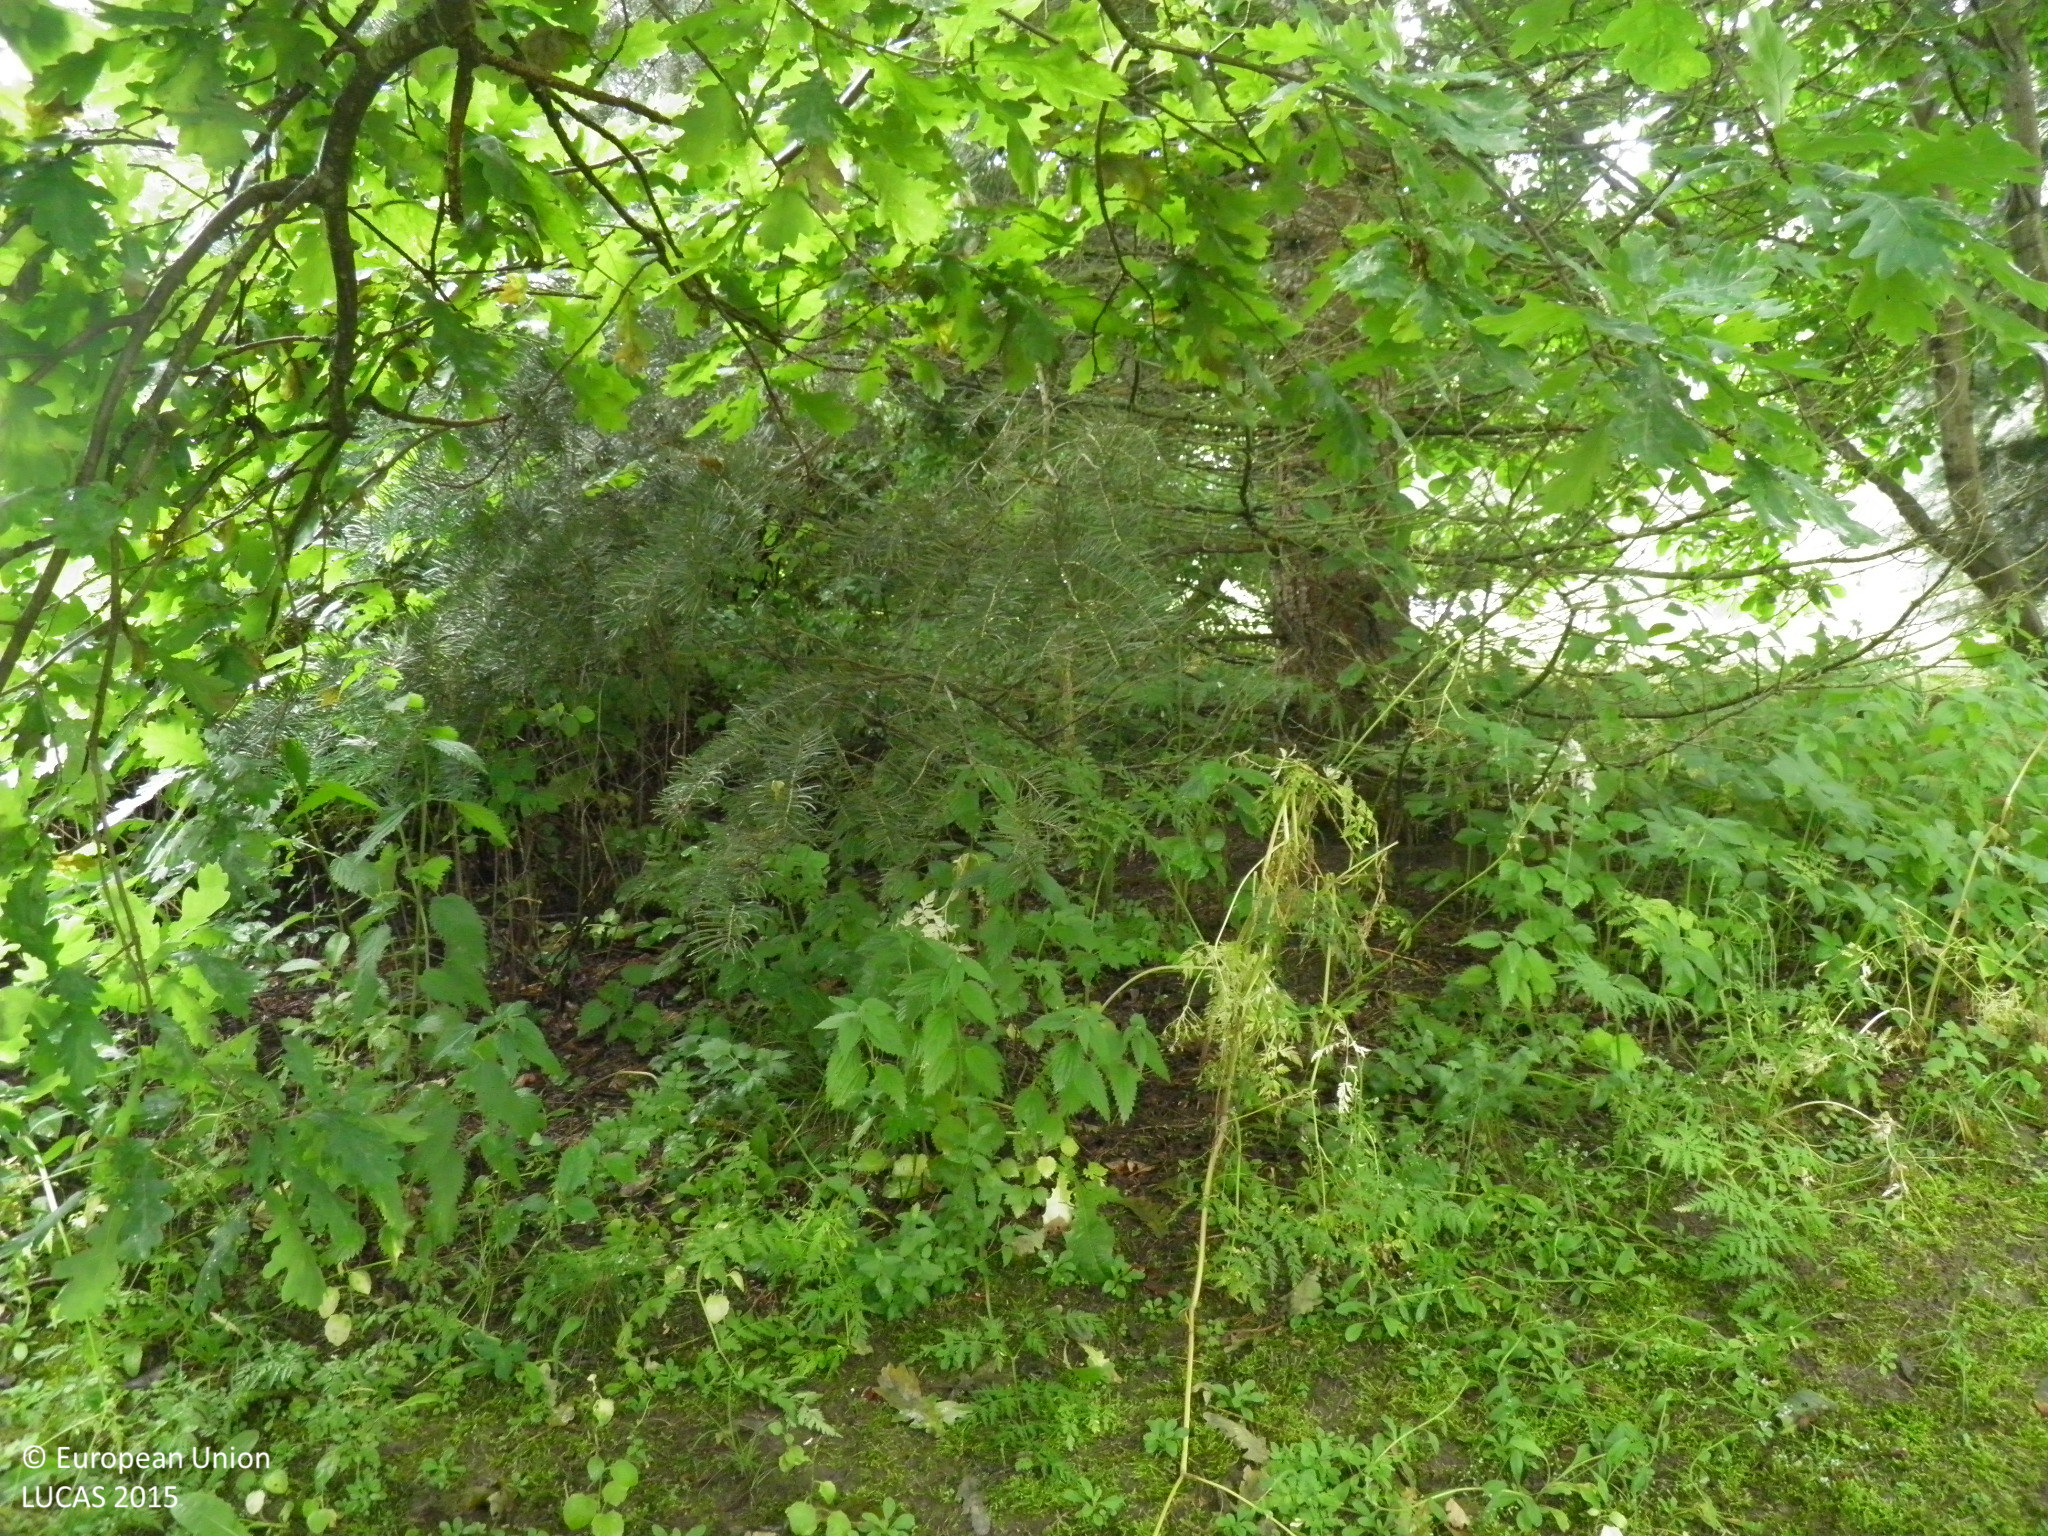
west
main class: Woodland
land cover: Spruce dominated mixed woodland
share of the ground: > 75 %
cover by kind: broadleaved forest trees 50 %, coniferous forest trees 25 %, herbaceous plants 15 %, shrubs 10 %
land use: Residential
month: July
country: FI
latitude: 60.1643
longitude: 22.5608
